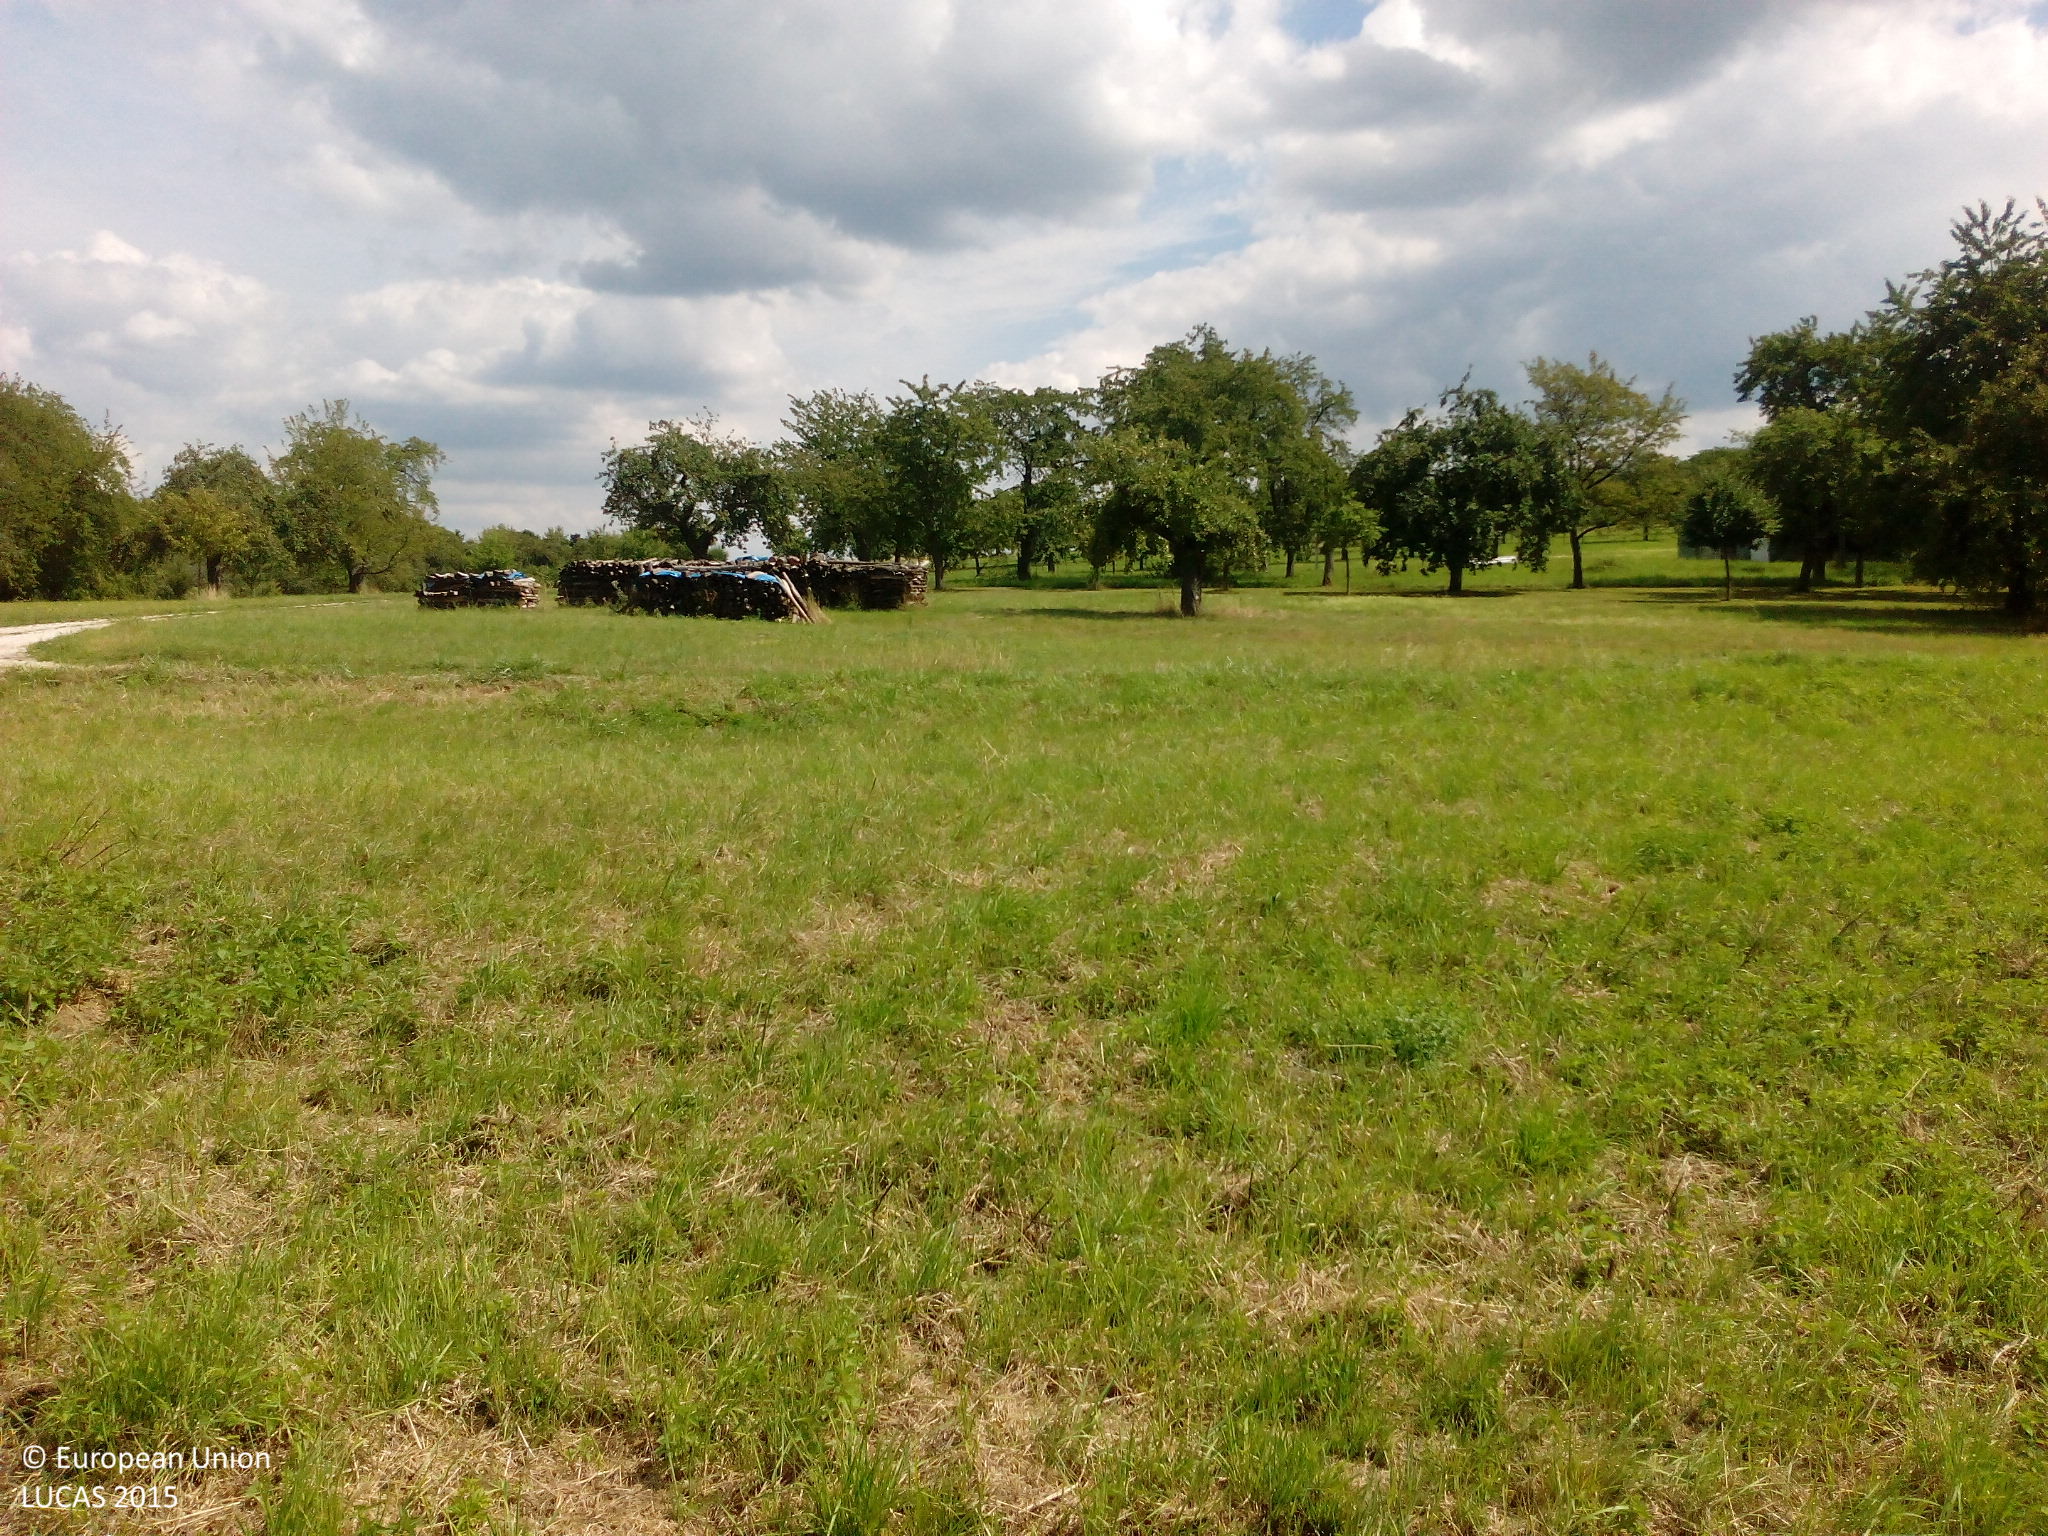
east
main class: Grassland
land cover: Grassland without tree/shrub cover
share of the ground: > 75 %
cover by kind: herbaceous plants 80 %, unconsolidated bare surface 20 %
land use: Agriculture (excluding fallow land and kitchen gardens)
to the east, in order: Grassland without tree/shrub cover; Tracks; Grassland without tree/shrub cover; Apple fruit; Grassland with sparse tree/shrub cover; Fences; Grassland with sparse tree/shrub cover; Fences; Tracks; Grassland without tree/shrub cover
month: August
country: DE
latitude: 50.2107
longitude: 7.4920
